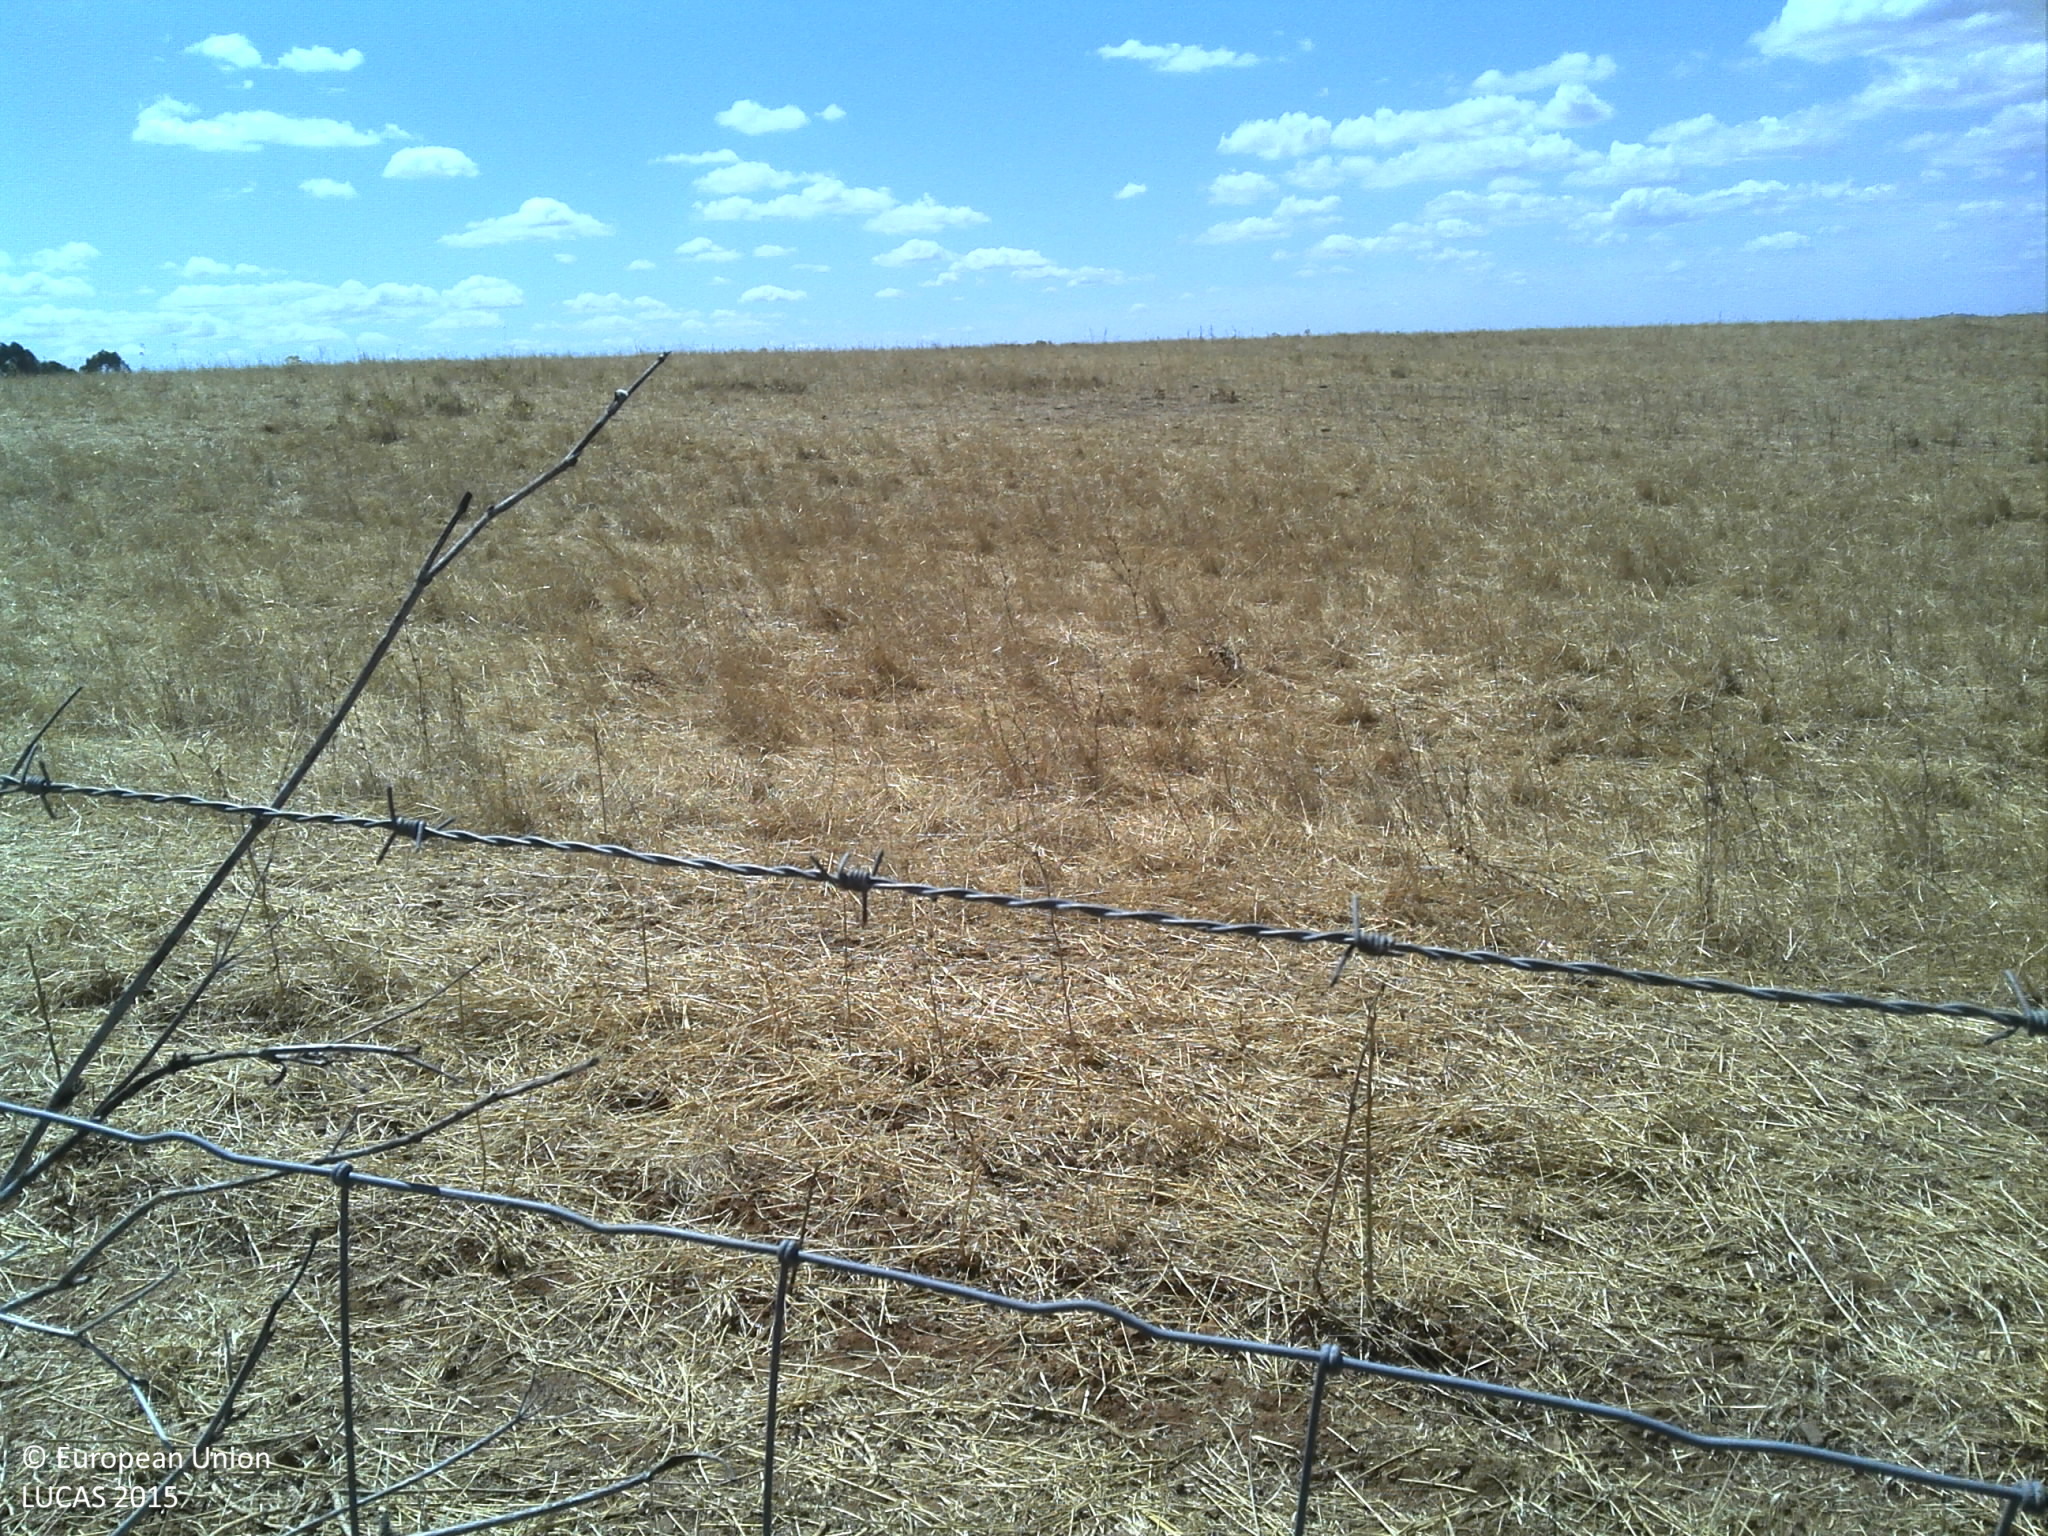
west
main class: Grassland
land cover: Grassland without tree/shrub cover
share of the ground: > 75 %
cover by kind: herbaceous plants 85 %, unconsolidated bare surface 15 %
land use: Agriculture (excluding fallow land and kitchen gardens)
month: July
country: PT
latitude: 38.0755
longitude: -7.8695
